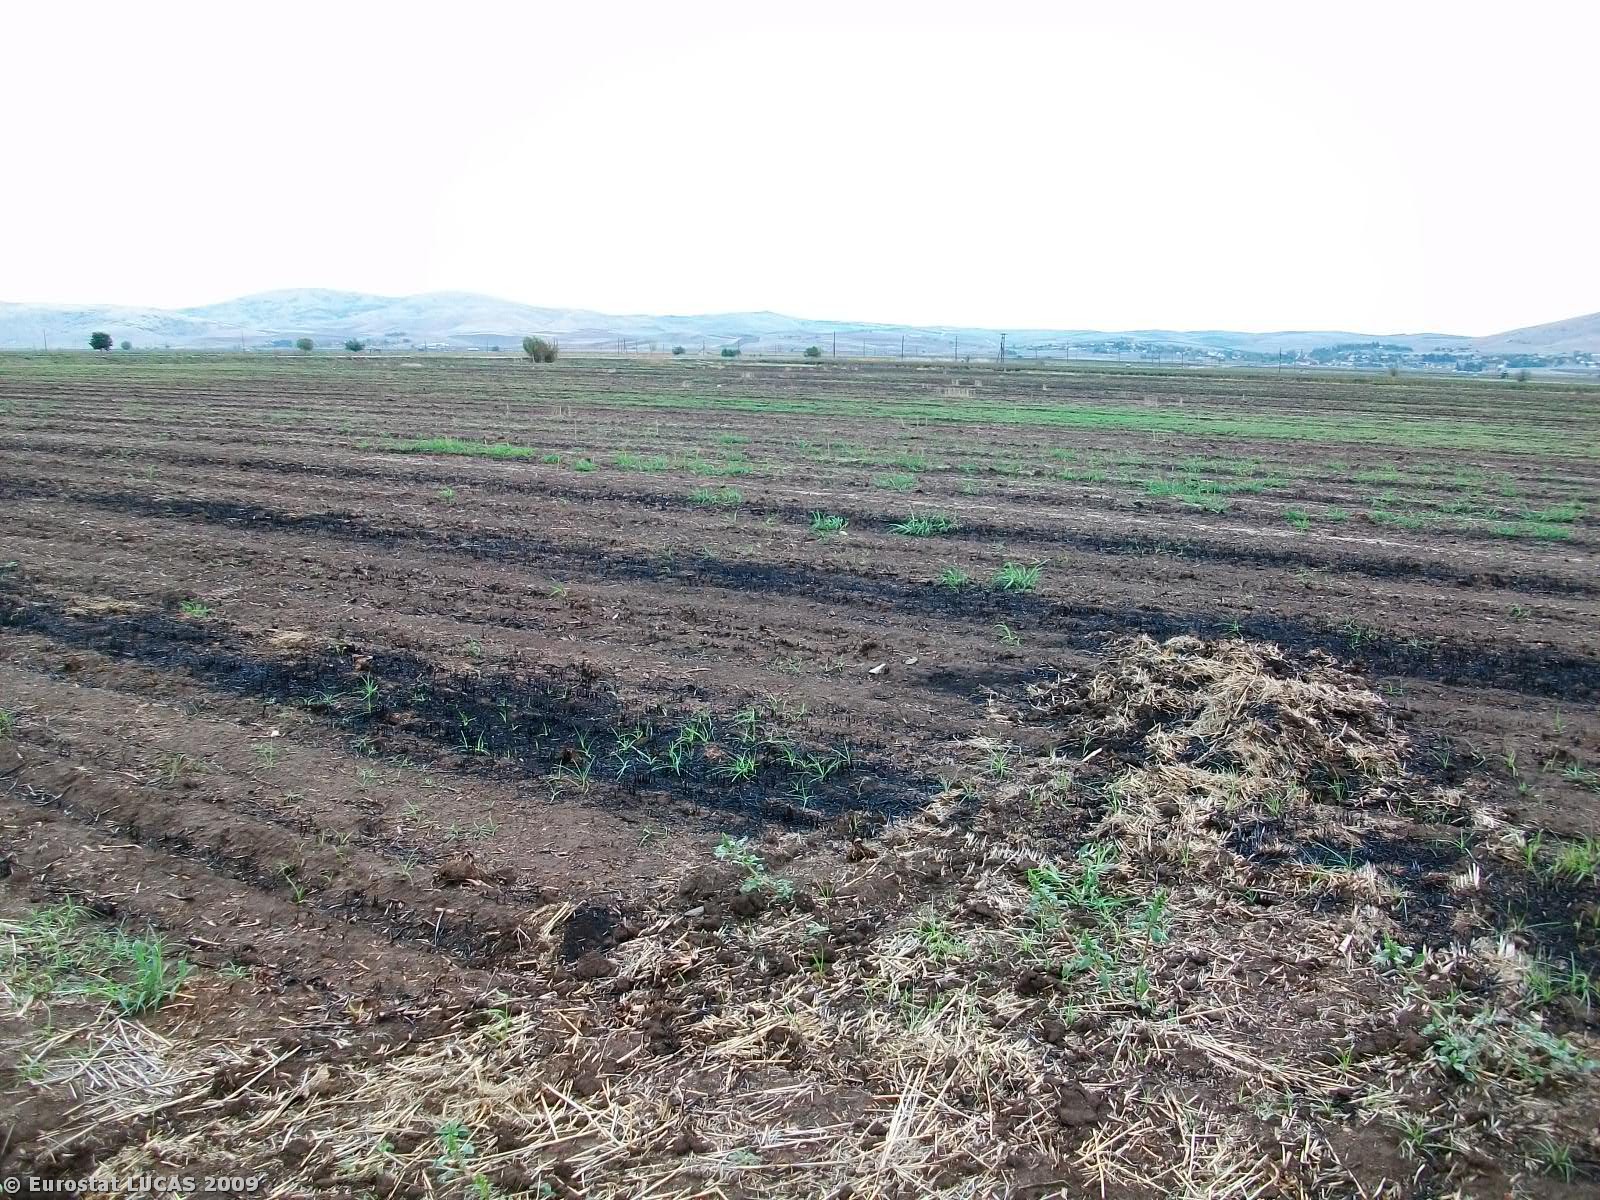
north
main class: Cropland
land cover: Maize
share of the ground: > 75 %
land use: Agriculture (excluding fallow land and kitchen gardens)
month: September
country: GR
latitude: 39.3564
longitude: 22.3451
